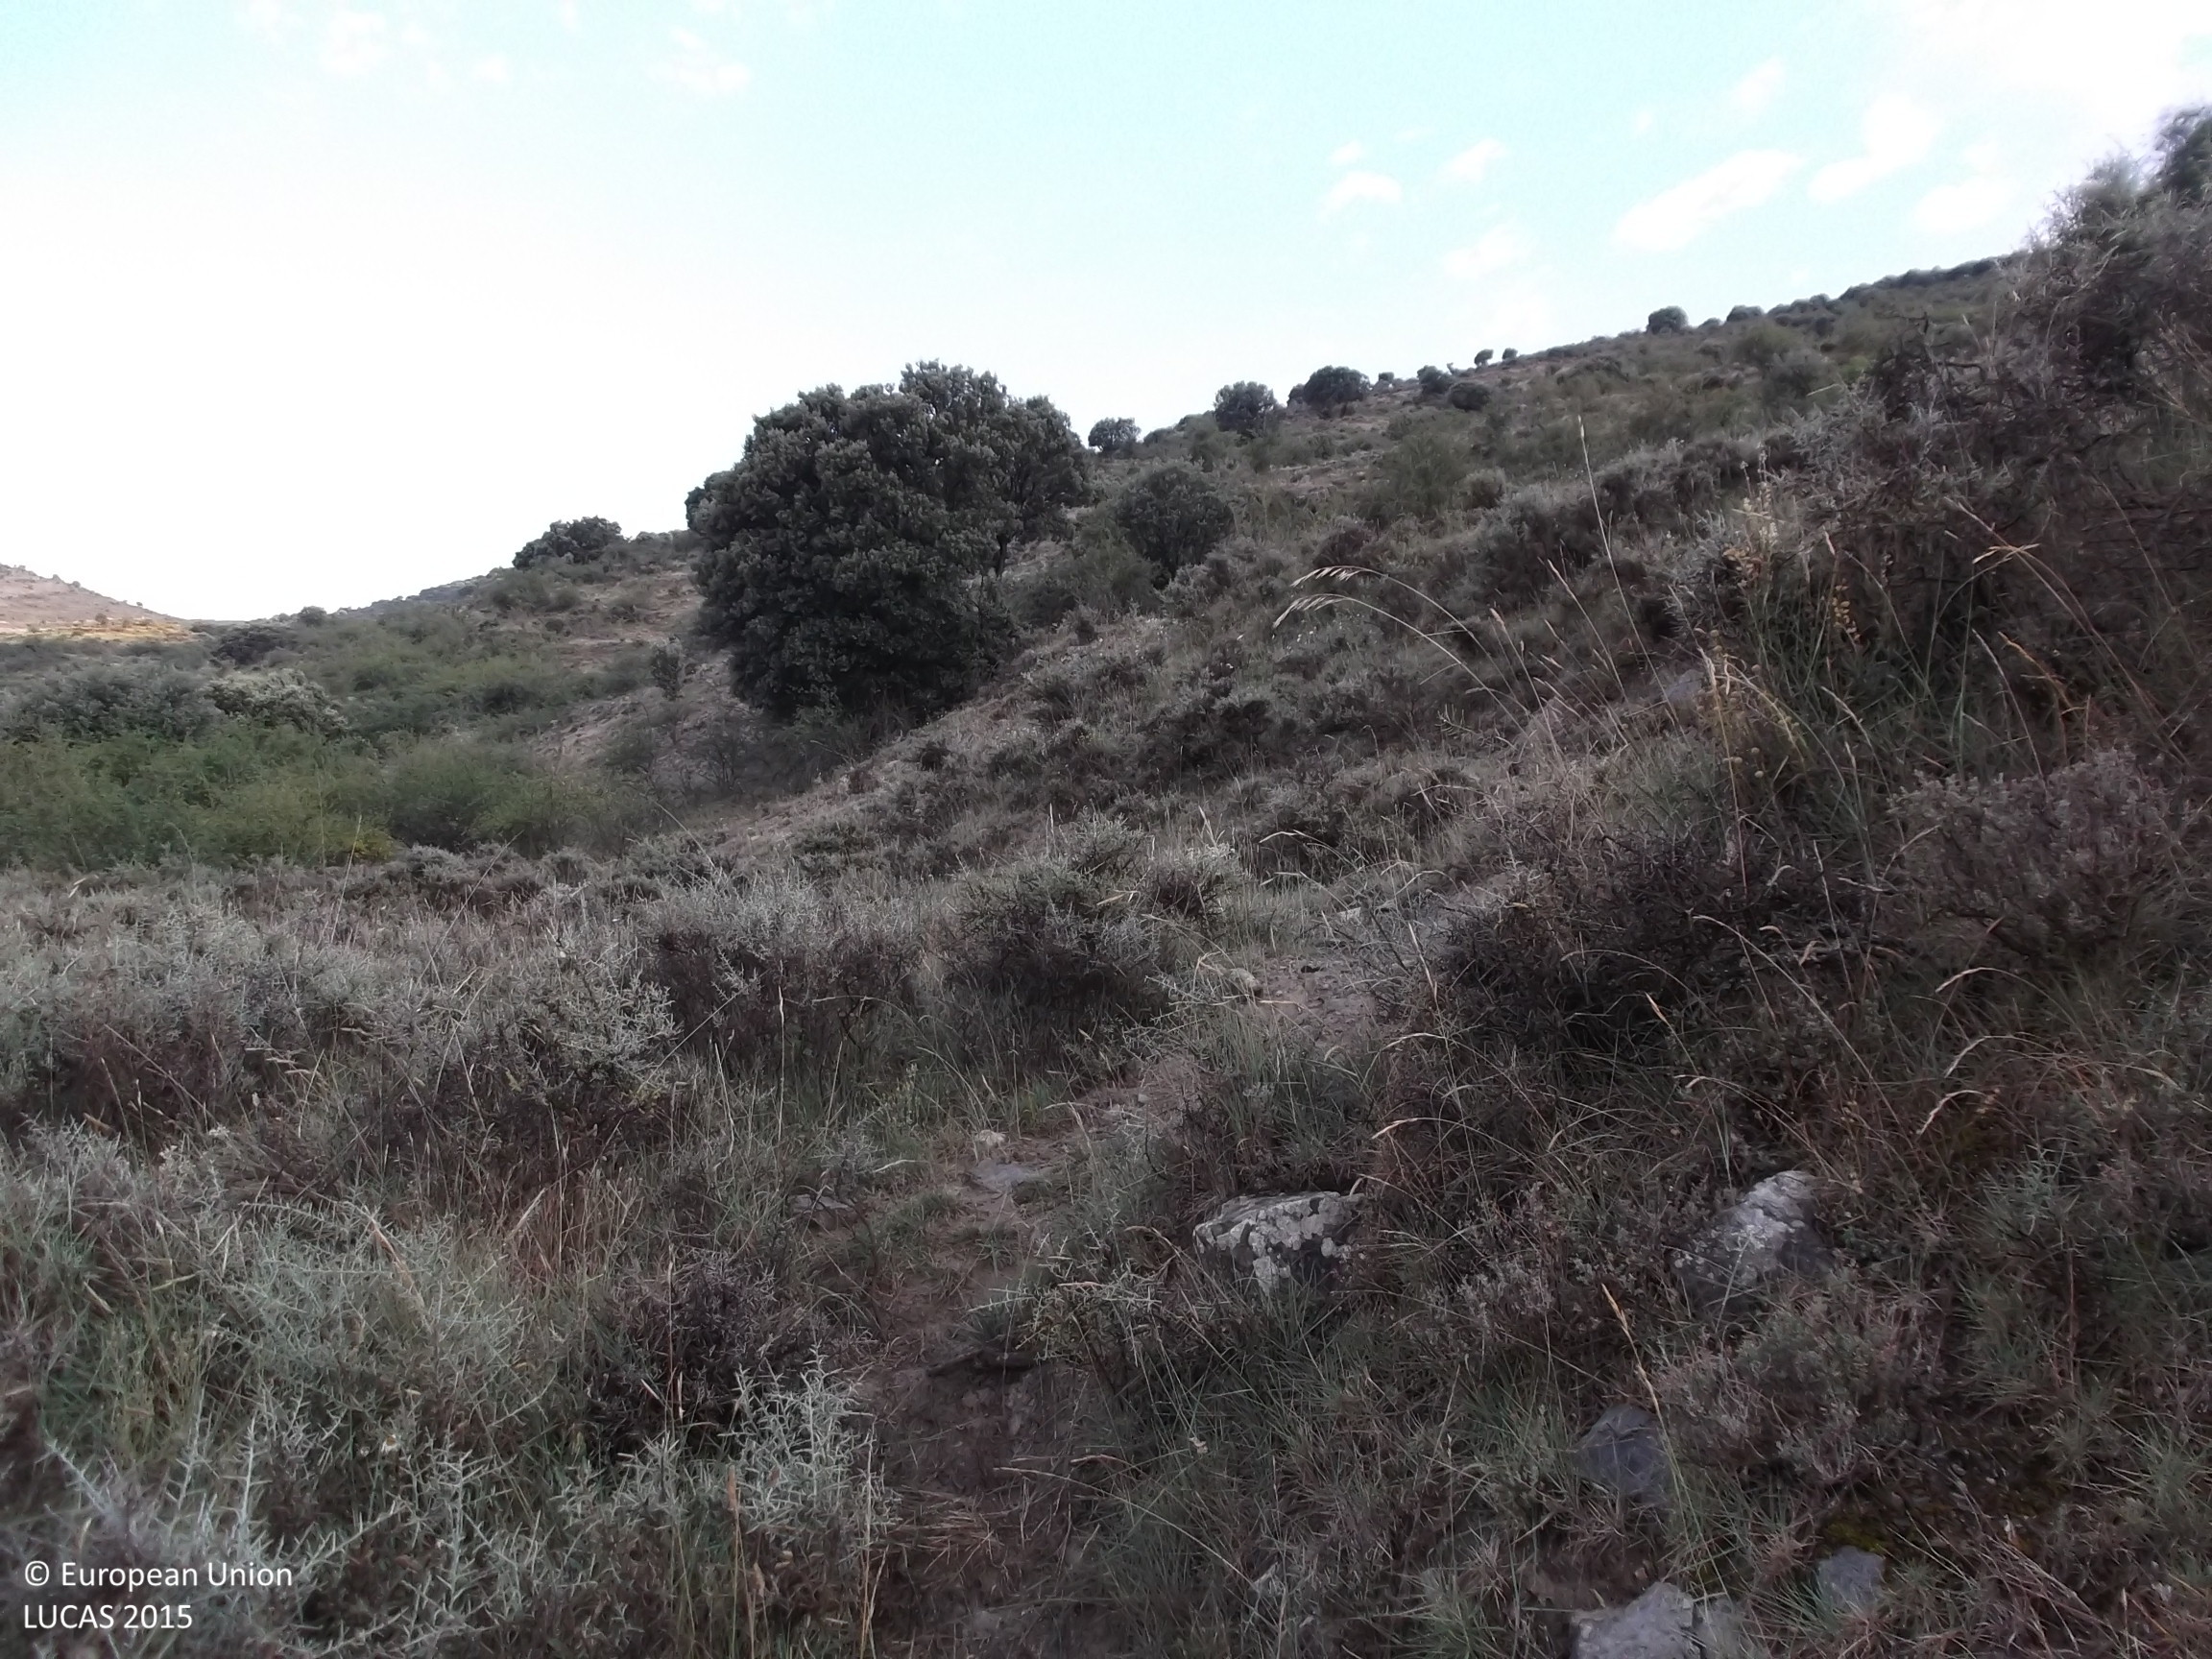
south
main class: Shrubland
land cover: Shrubland with sparse tree cover
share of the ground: > 75 %
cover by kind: shrubs 80 %, herbaceous plants 10 %, broadleaved forest trees 5 %, unconsolidated bare surface 5 %
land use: Agriculture (excluding fallow land and kitchen gardens)
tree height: < 5 m
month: July
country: ES
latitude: 42.1419
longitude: -2.2724
